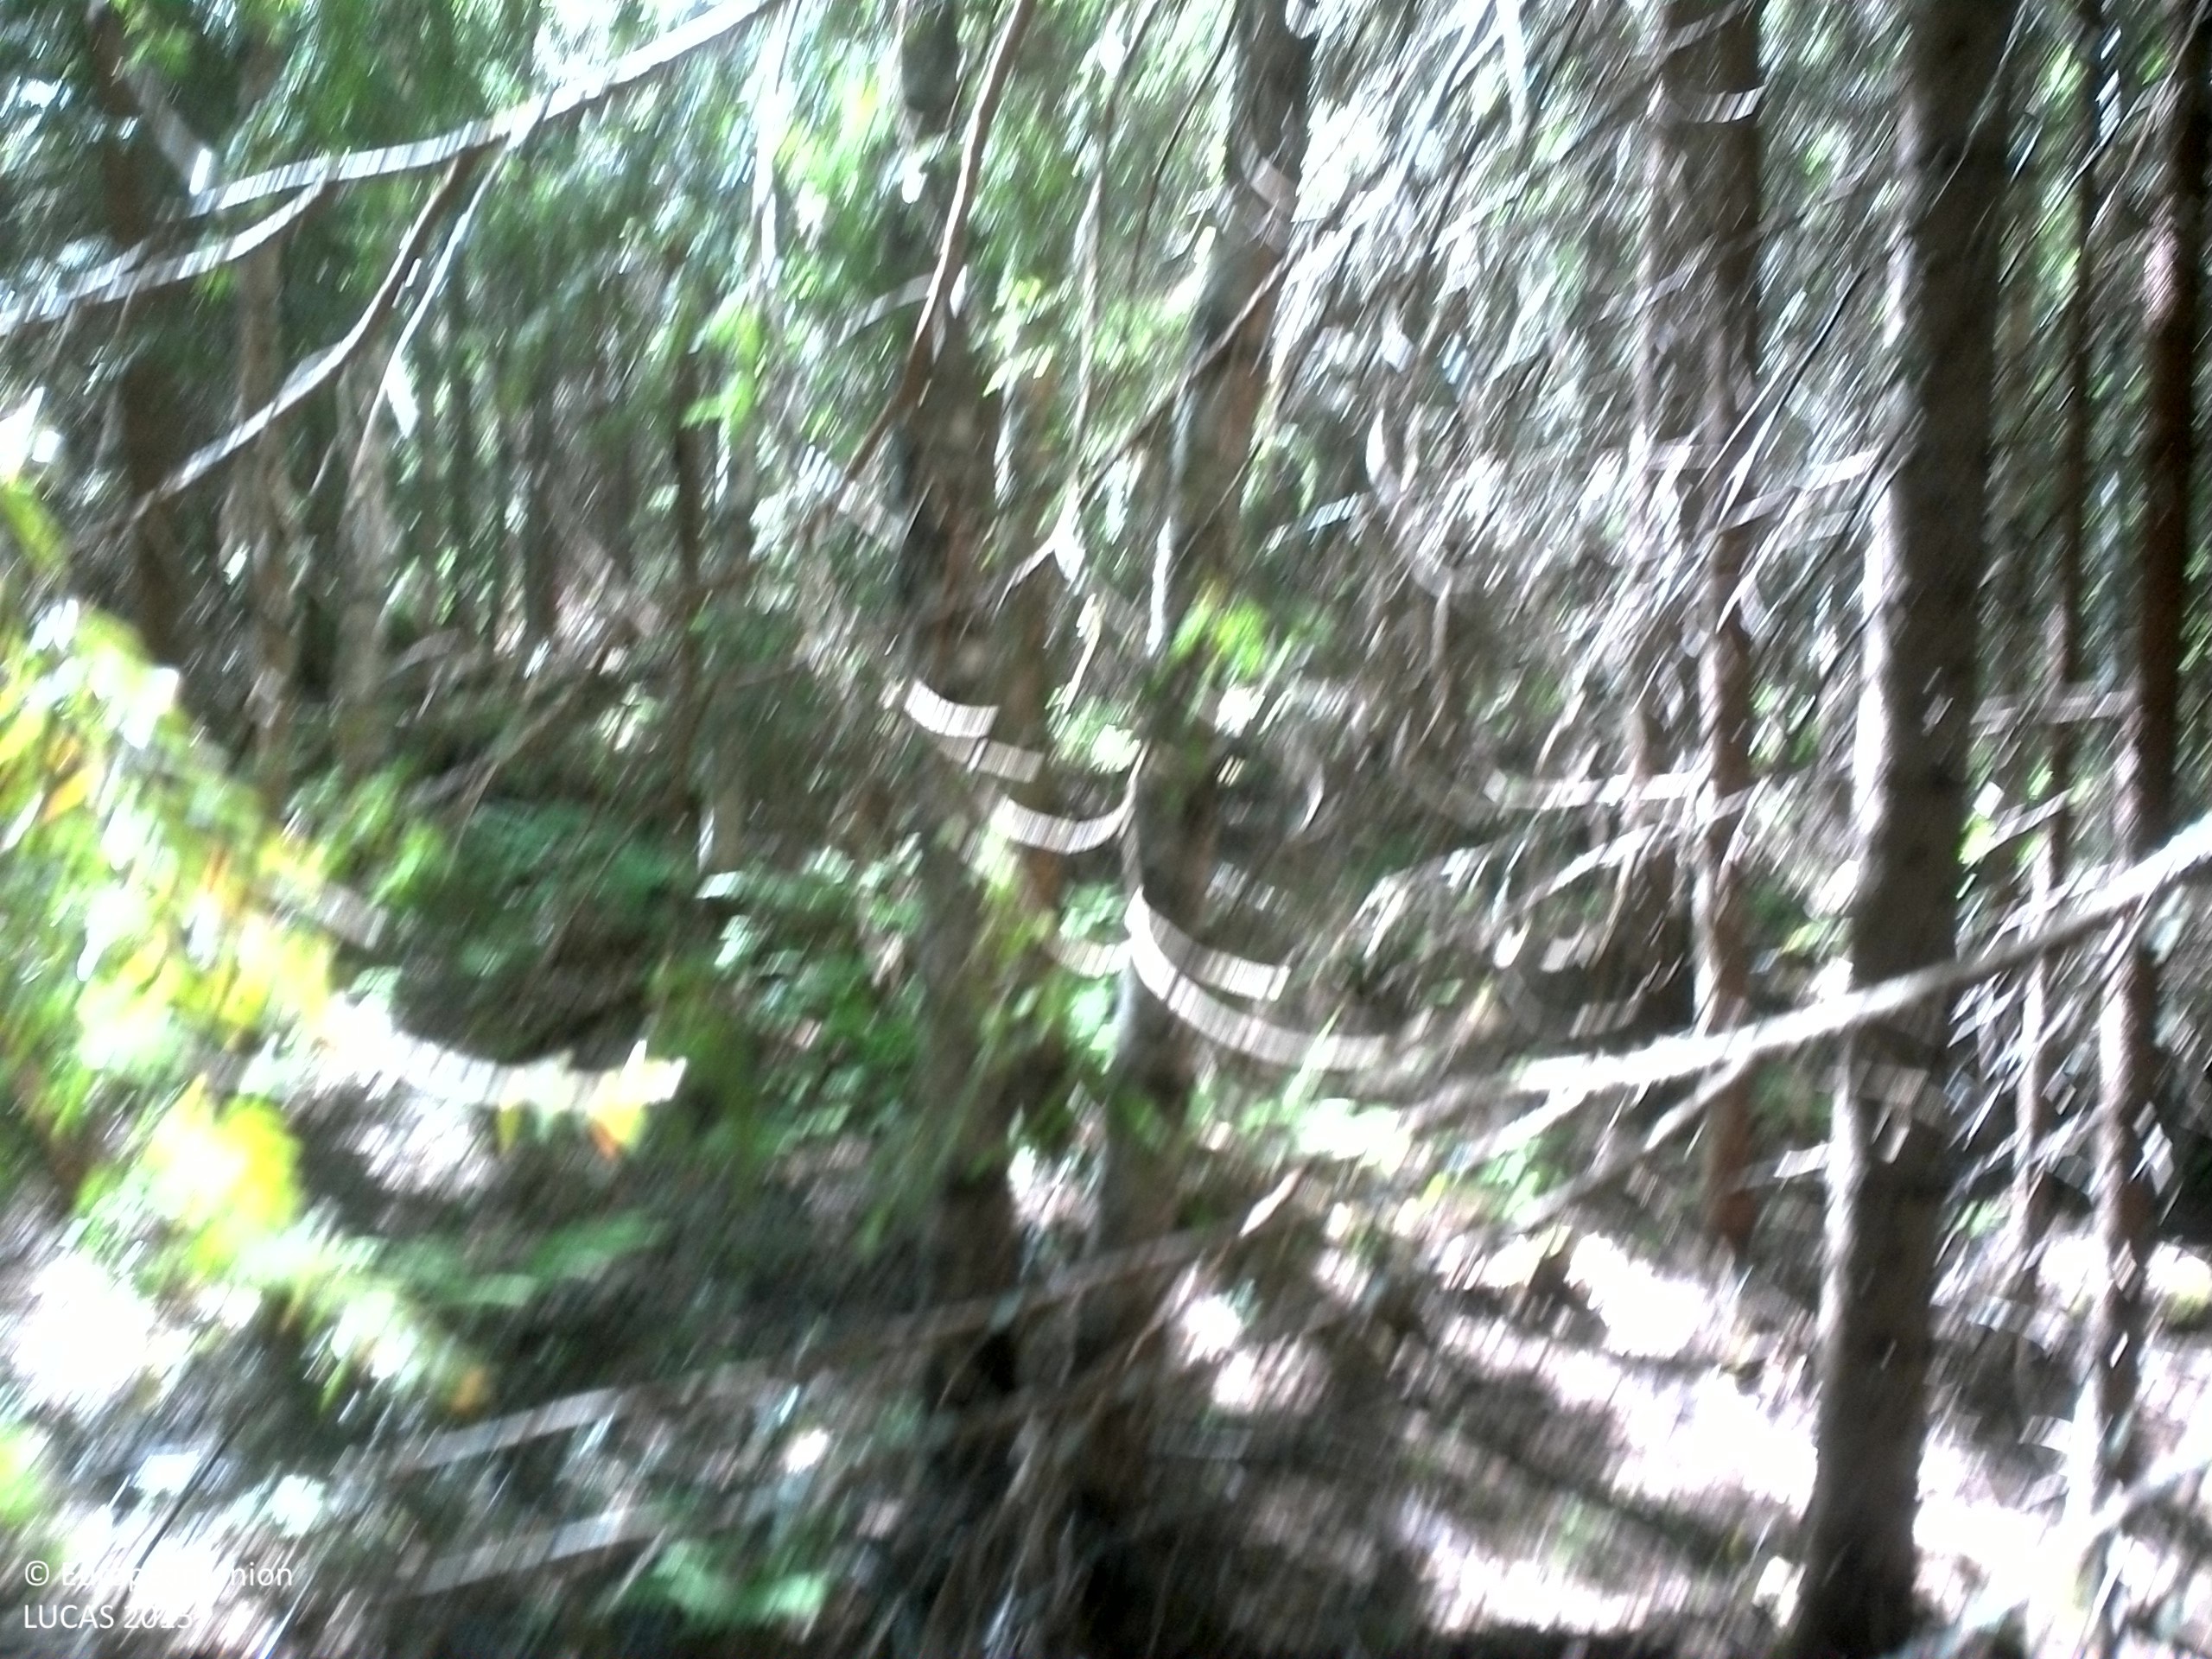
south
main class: Woodland
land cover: Spruce dominated mixed woodland
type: boreal forest
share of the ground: > 75 %
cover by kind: coniferous forest trees 65 %, broadleaved forest trees 25 %, herbaceous plants 10 %
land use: Forestry
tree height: > 5 m
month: July
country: SE
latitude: 62.7808
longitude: 17.6411
